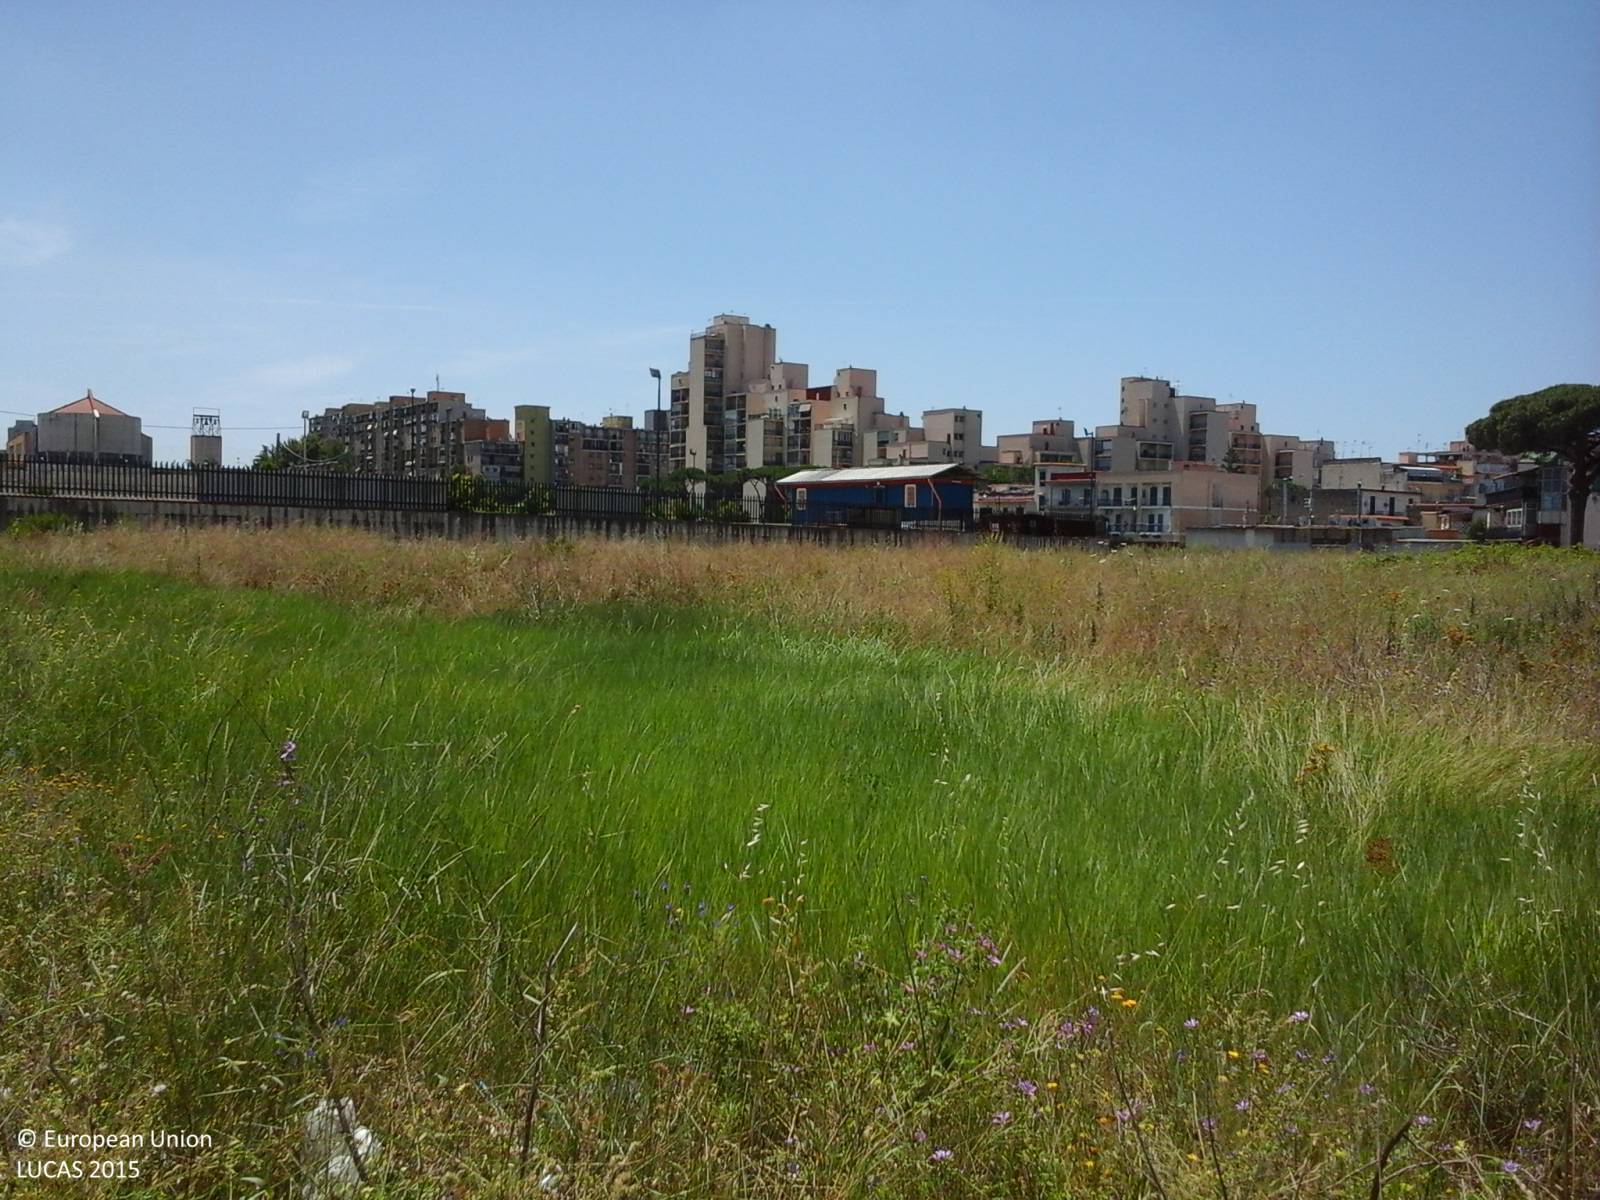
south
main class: Shrubland
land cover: Shrubland with sparse tree cover
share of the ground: > 75 %
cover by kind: shrubs 50 %, herbaceous plants 45 %, broadleaved forest trees 5 %
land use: Abandoned areas
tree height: < 5 m
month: June
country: IT
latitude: 40.8600
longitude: 14.3359
